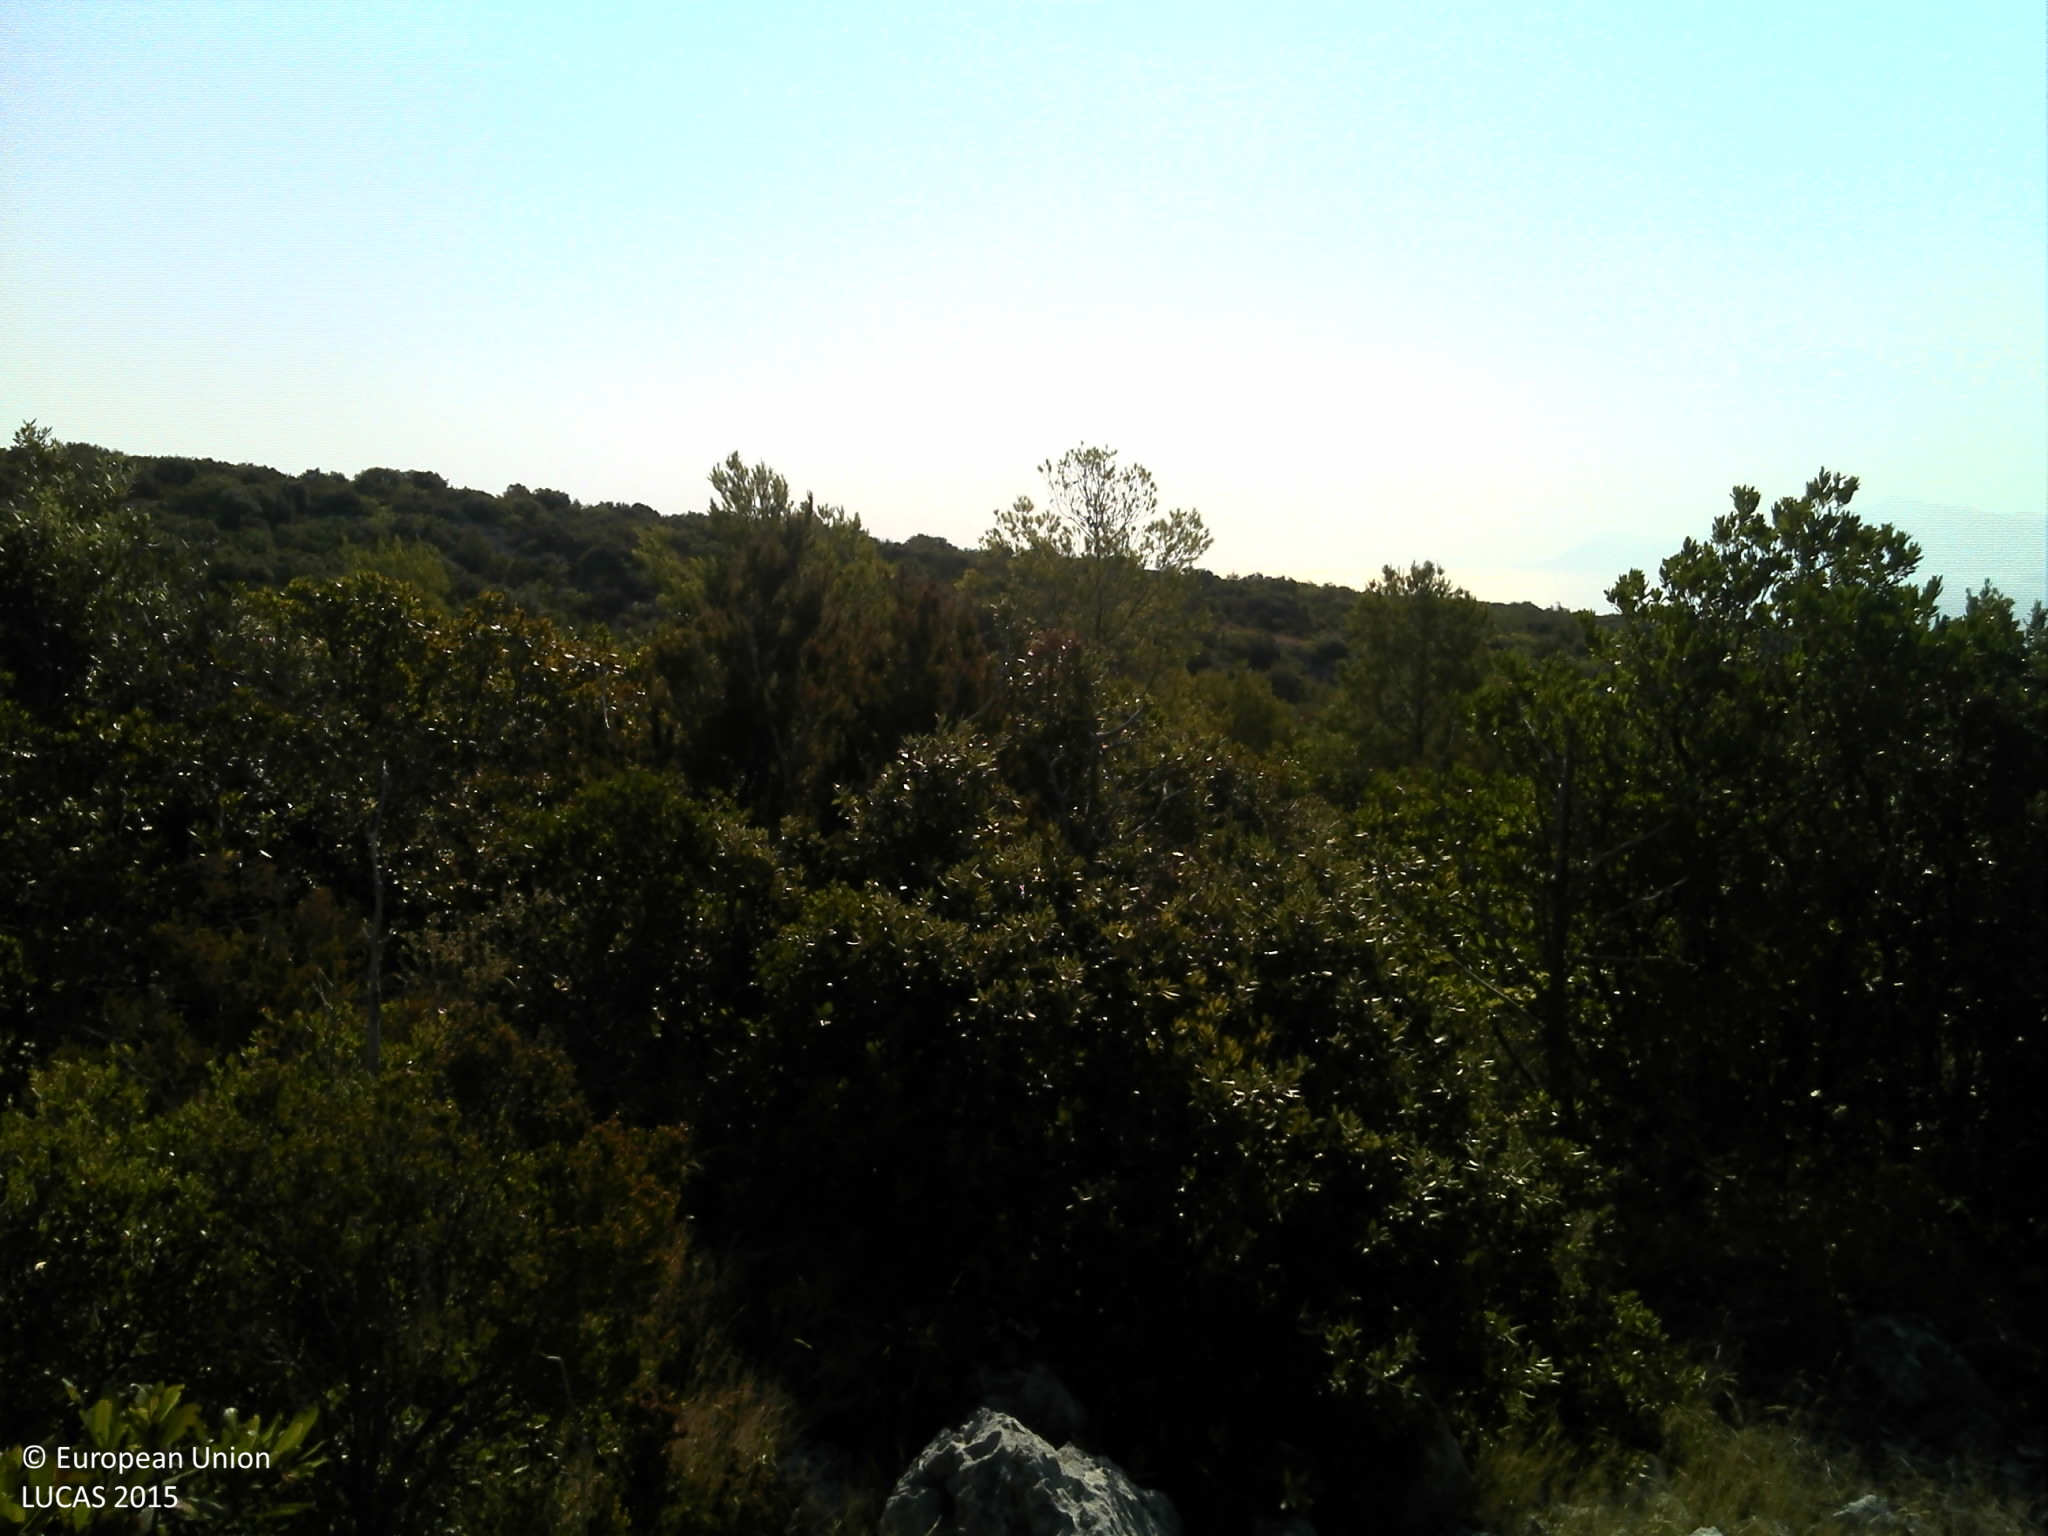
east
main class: Shrubland
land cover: Shrubland with sparse tree cover
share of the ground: > 75 %
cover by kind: shrubs 75 %, herbaceous plants 10 %, broadleaved forest trees 5 %, consolidated bare surface 5 %, unconsolidated bare surface 5 %
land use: Semi-natural and natural areas not in use
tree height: < 5 m
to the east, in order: Shrubland with sparse tree cover; Dry stone walls; Shrubland with sparse tree cover
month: August
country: HR
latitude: 43.1277
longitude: 16.8611
